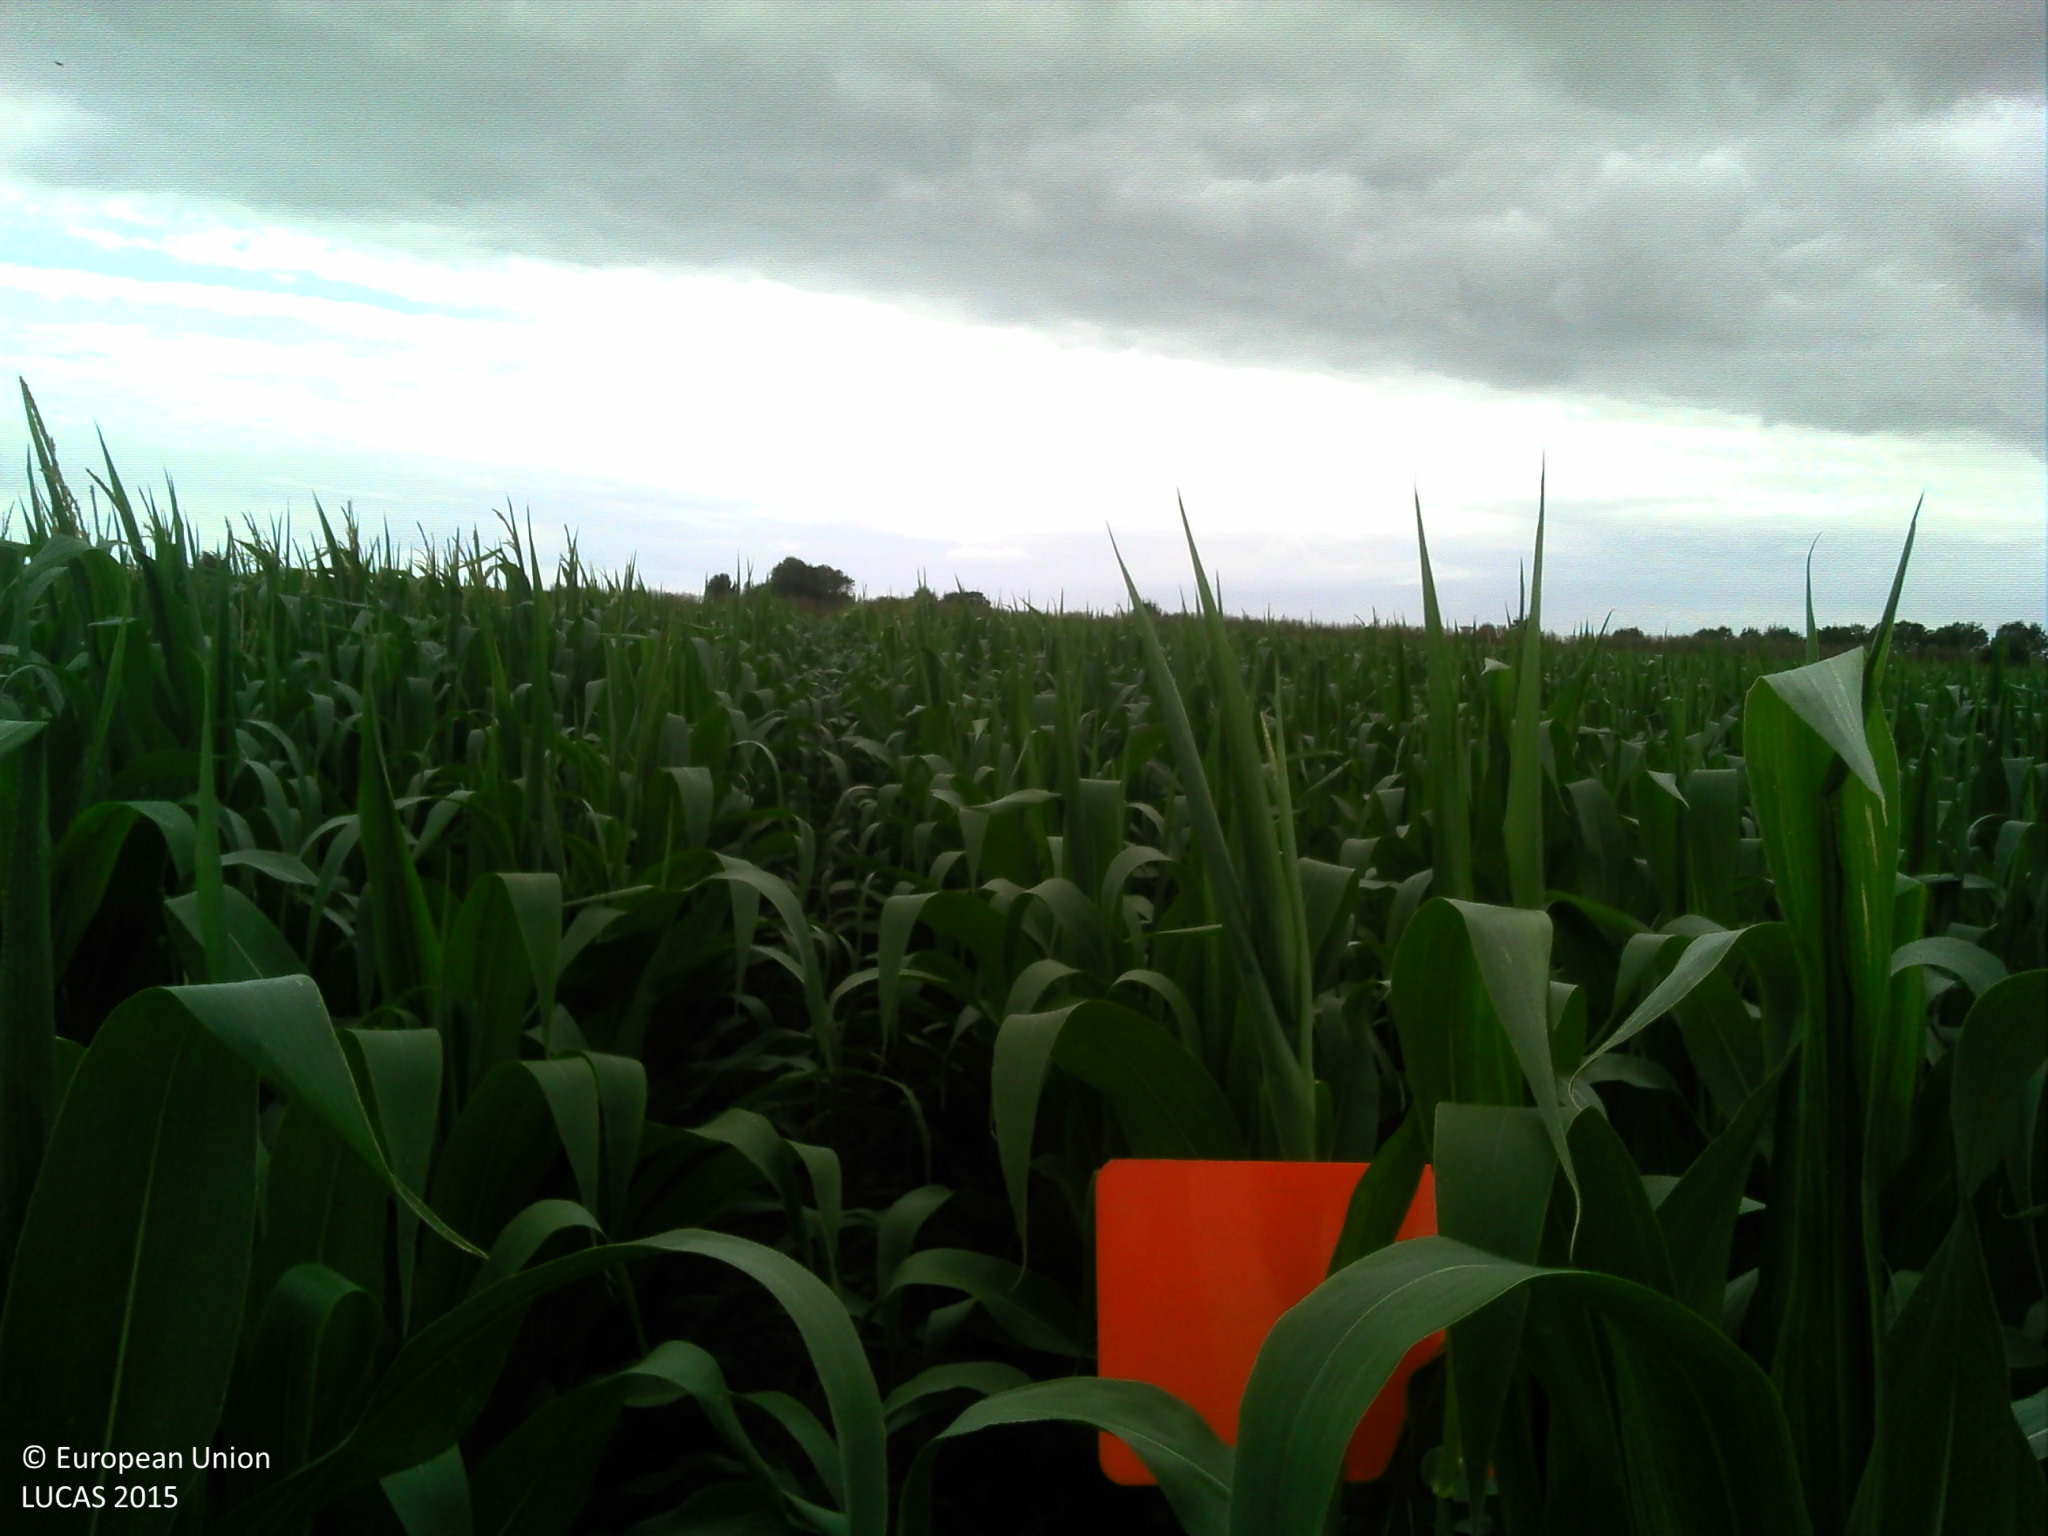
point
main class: Cropland
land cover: Maize
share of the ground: > 75 %
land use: Agriculture (excluding fallow land and kitchen gardens)
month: July
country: FR
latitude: 46.3624
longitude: -1.3562
